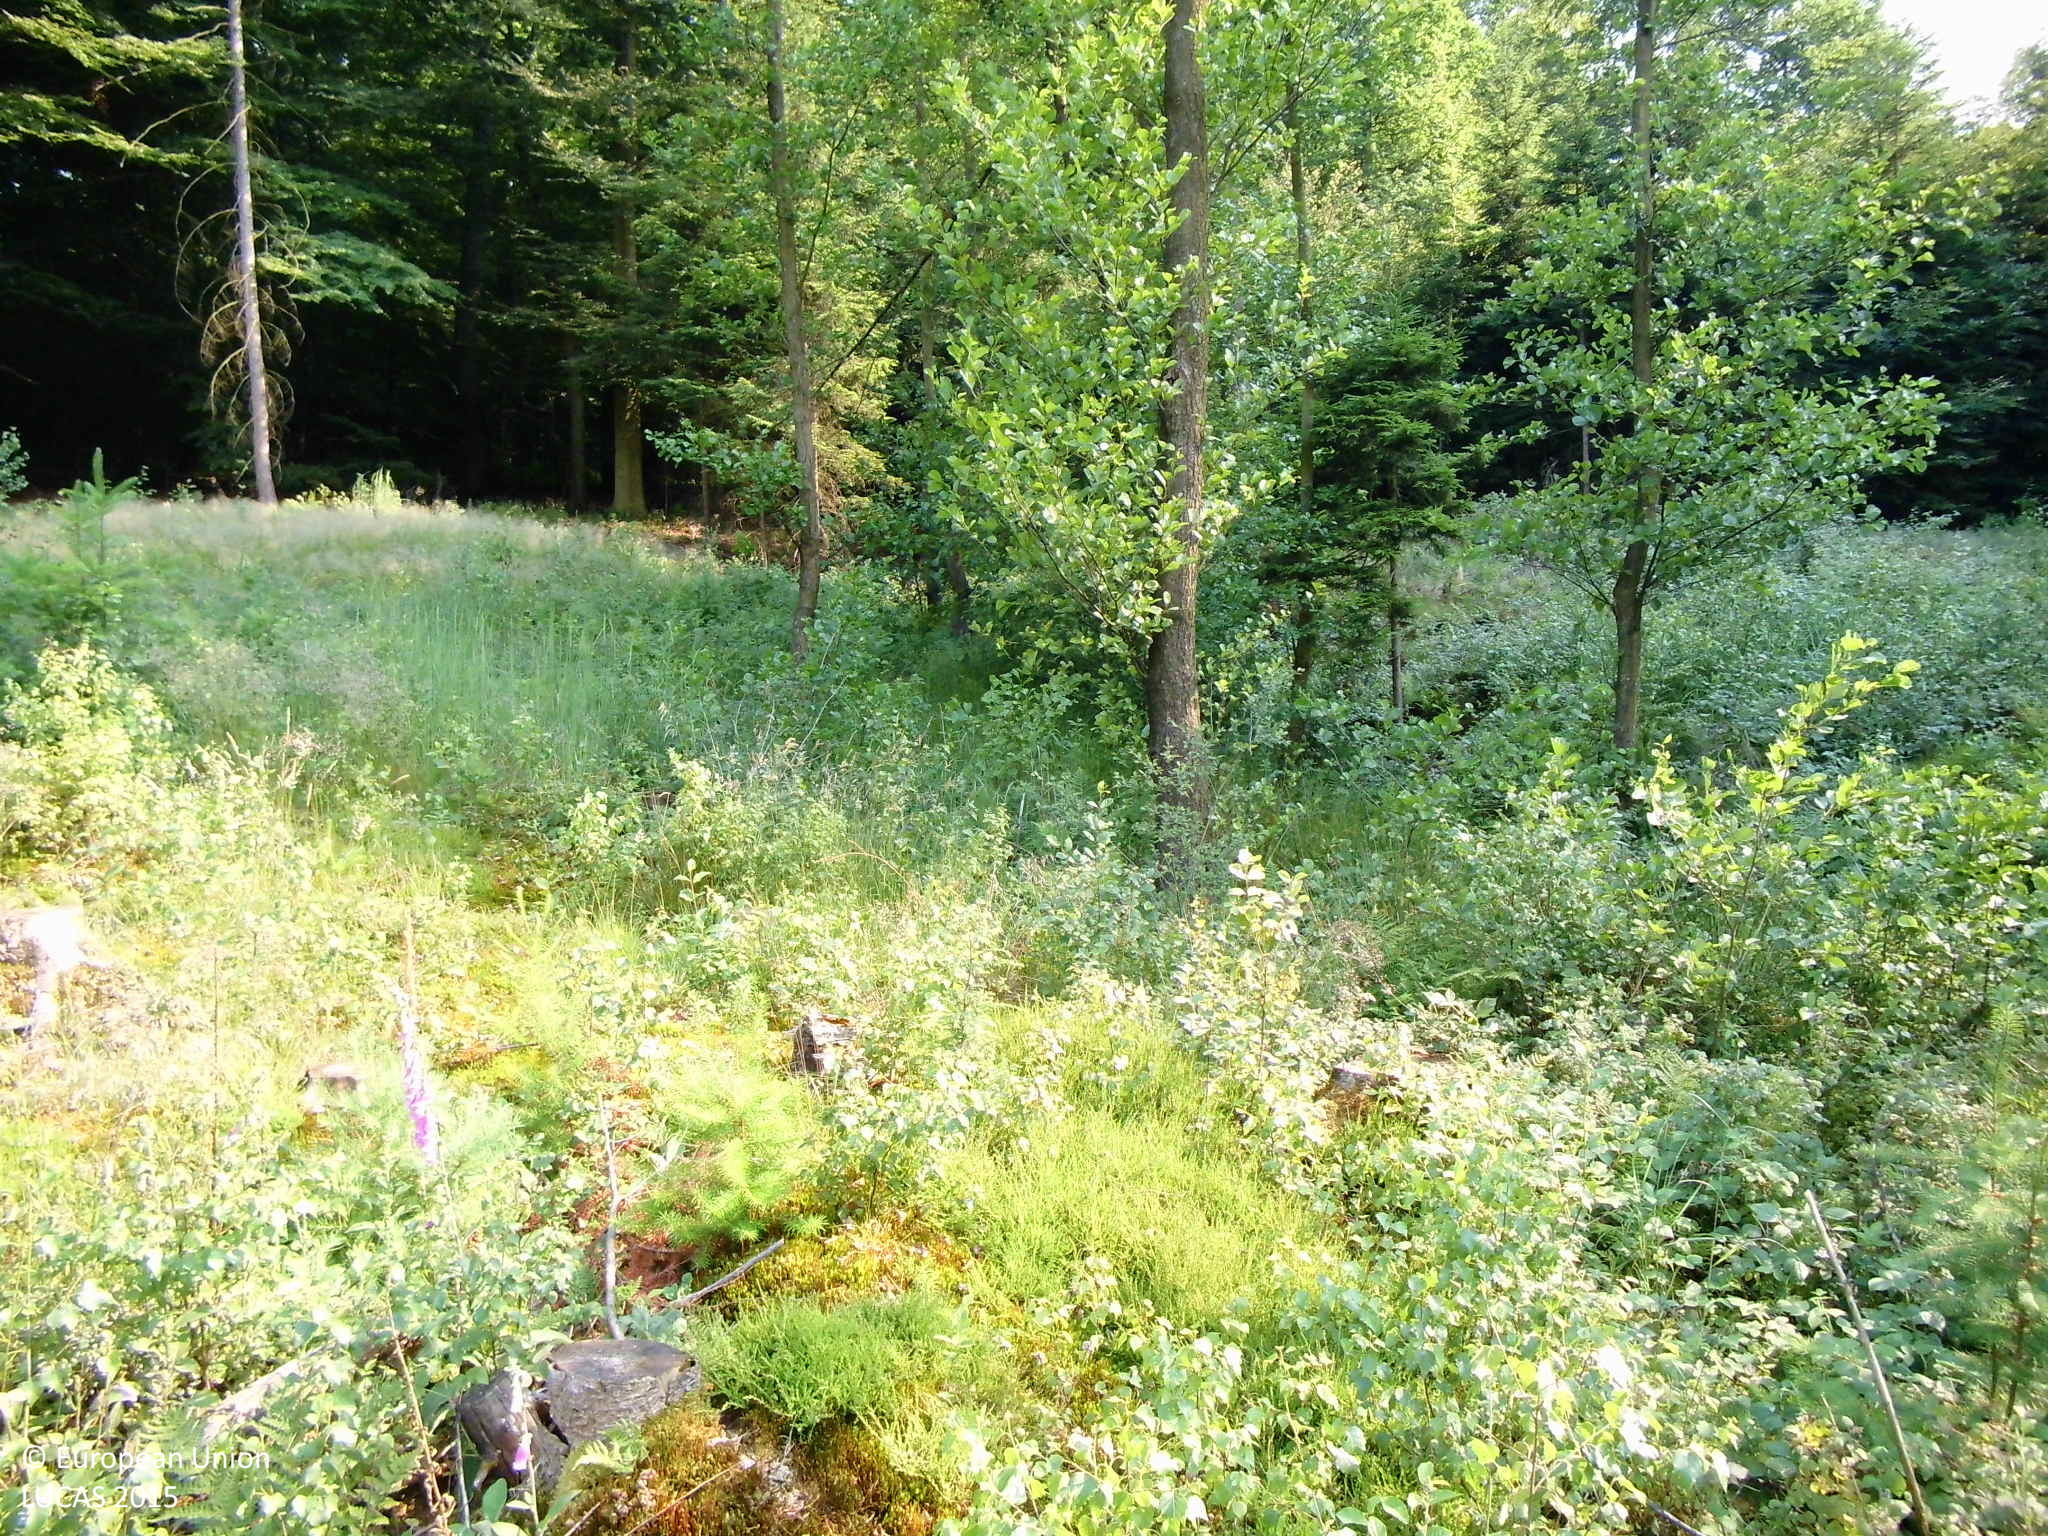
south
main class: Shrubland
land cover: Shrubland with sparse tree cover
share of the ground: 50 - 75 %
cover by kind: shrubs 50 %, herbaceous plants 35 %, broadleaved forest trees 5 %, lichens and mosses 5 %, unconsolidated bare surface 5 %
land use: Forestry
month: July
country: DE
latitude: 51.3538
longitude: 8.0044
